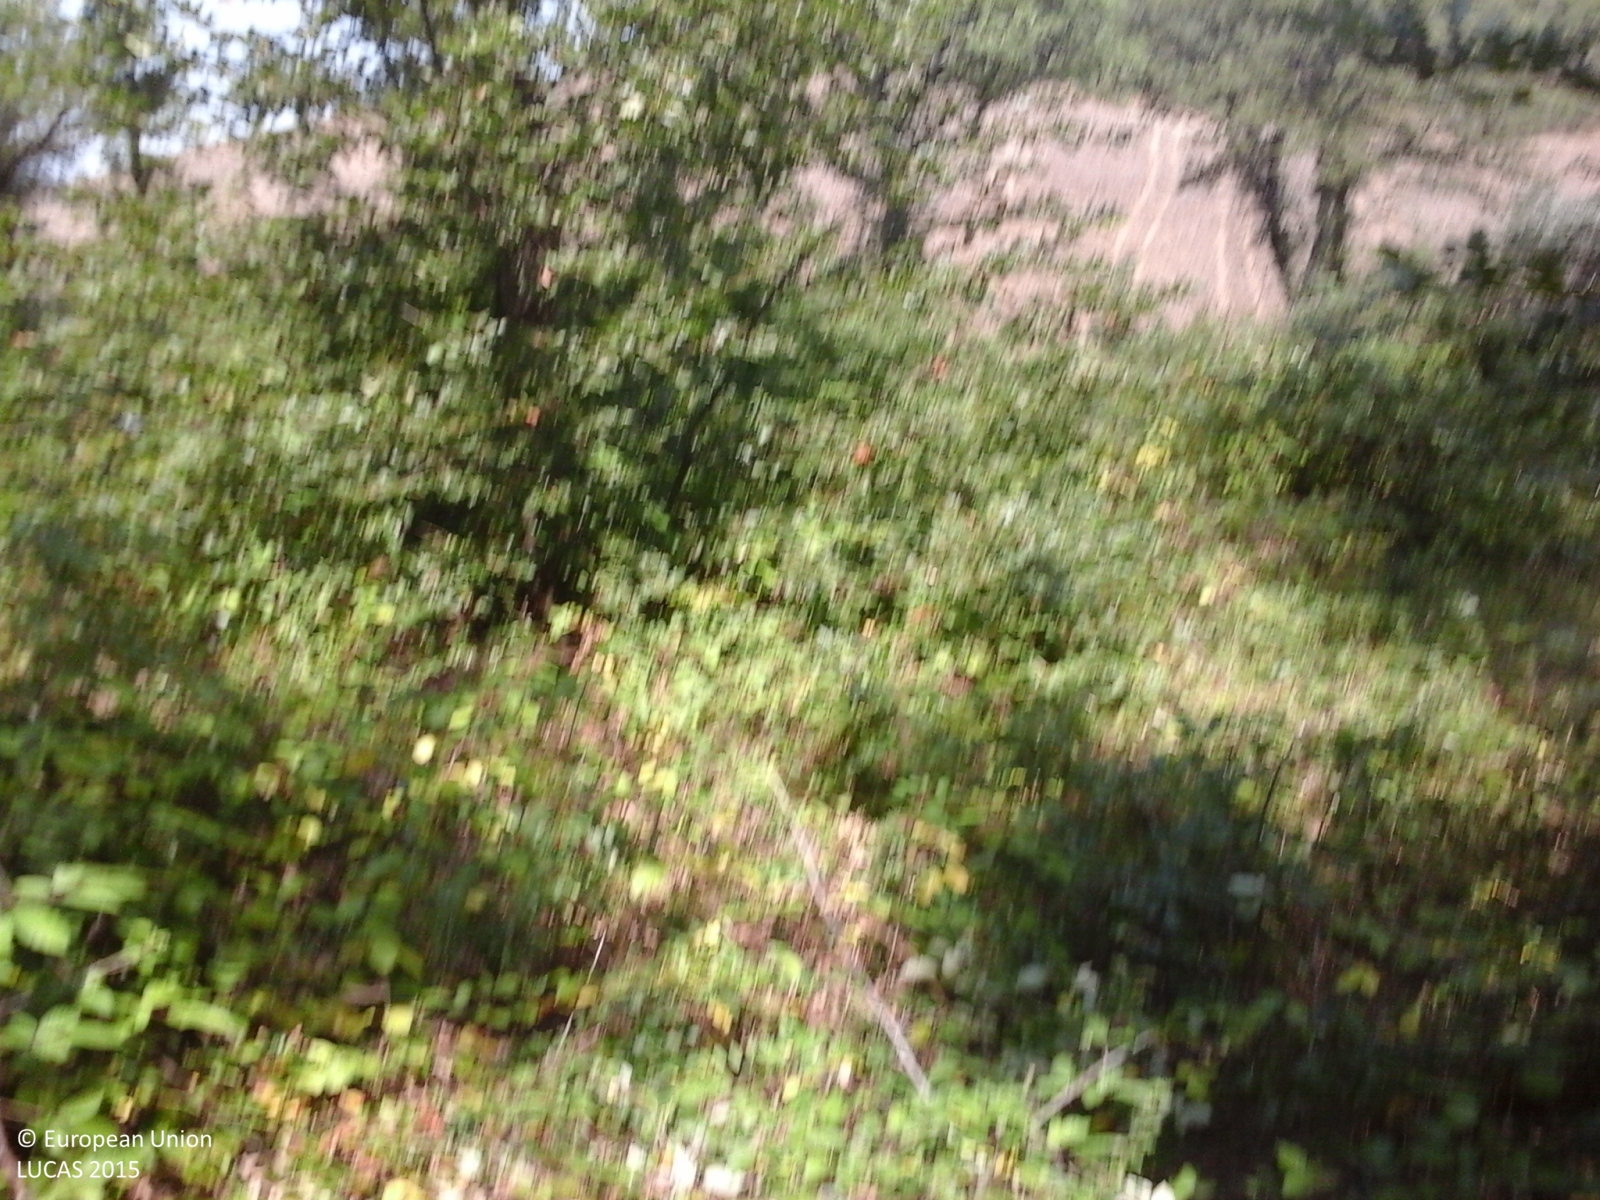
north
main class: Woodland
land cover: Broadleaved woodland
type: thermophilous deciduous forest
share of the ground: 25 - 50 %
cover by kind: broadleaved forest trees 55 %, shrubs 40 %, herbaceous plants 5 %
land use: Forestry
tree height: > 5 m
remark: Clear cut
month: July
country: IT
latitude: 43.1113
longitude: 11.5805
